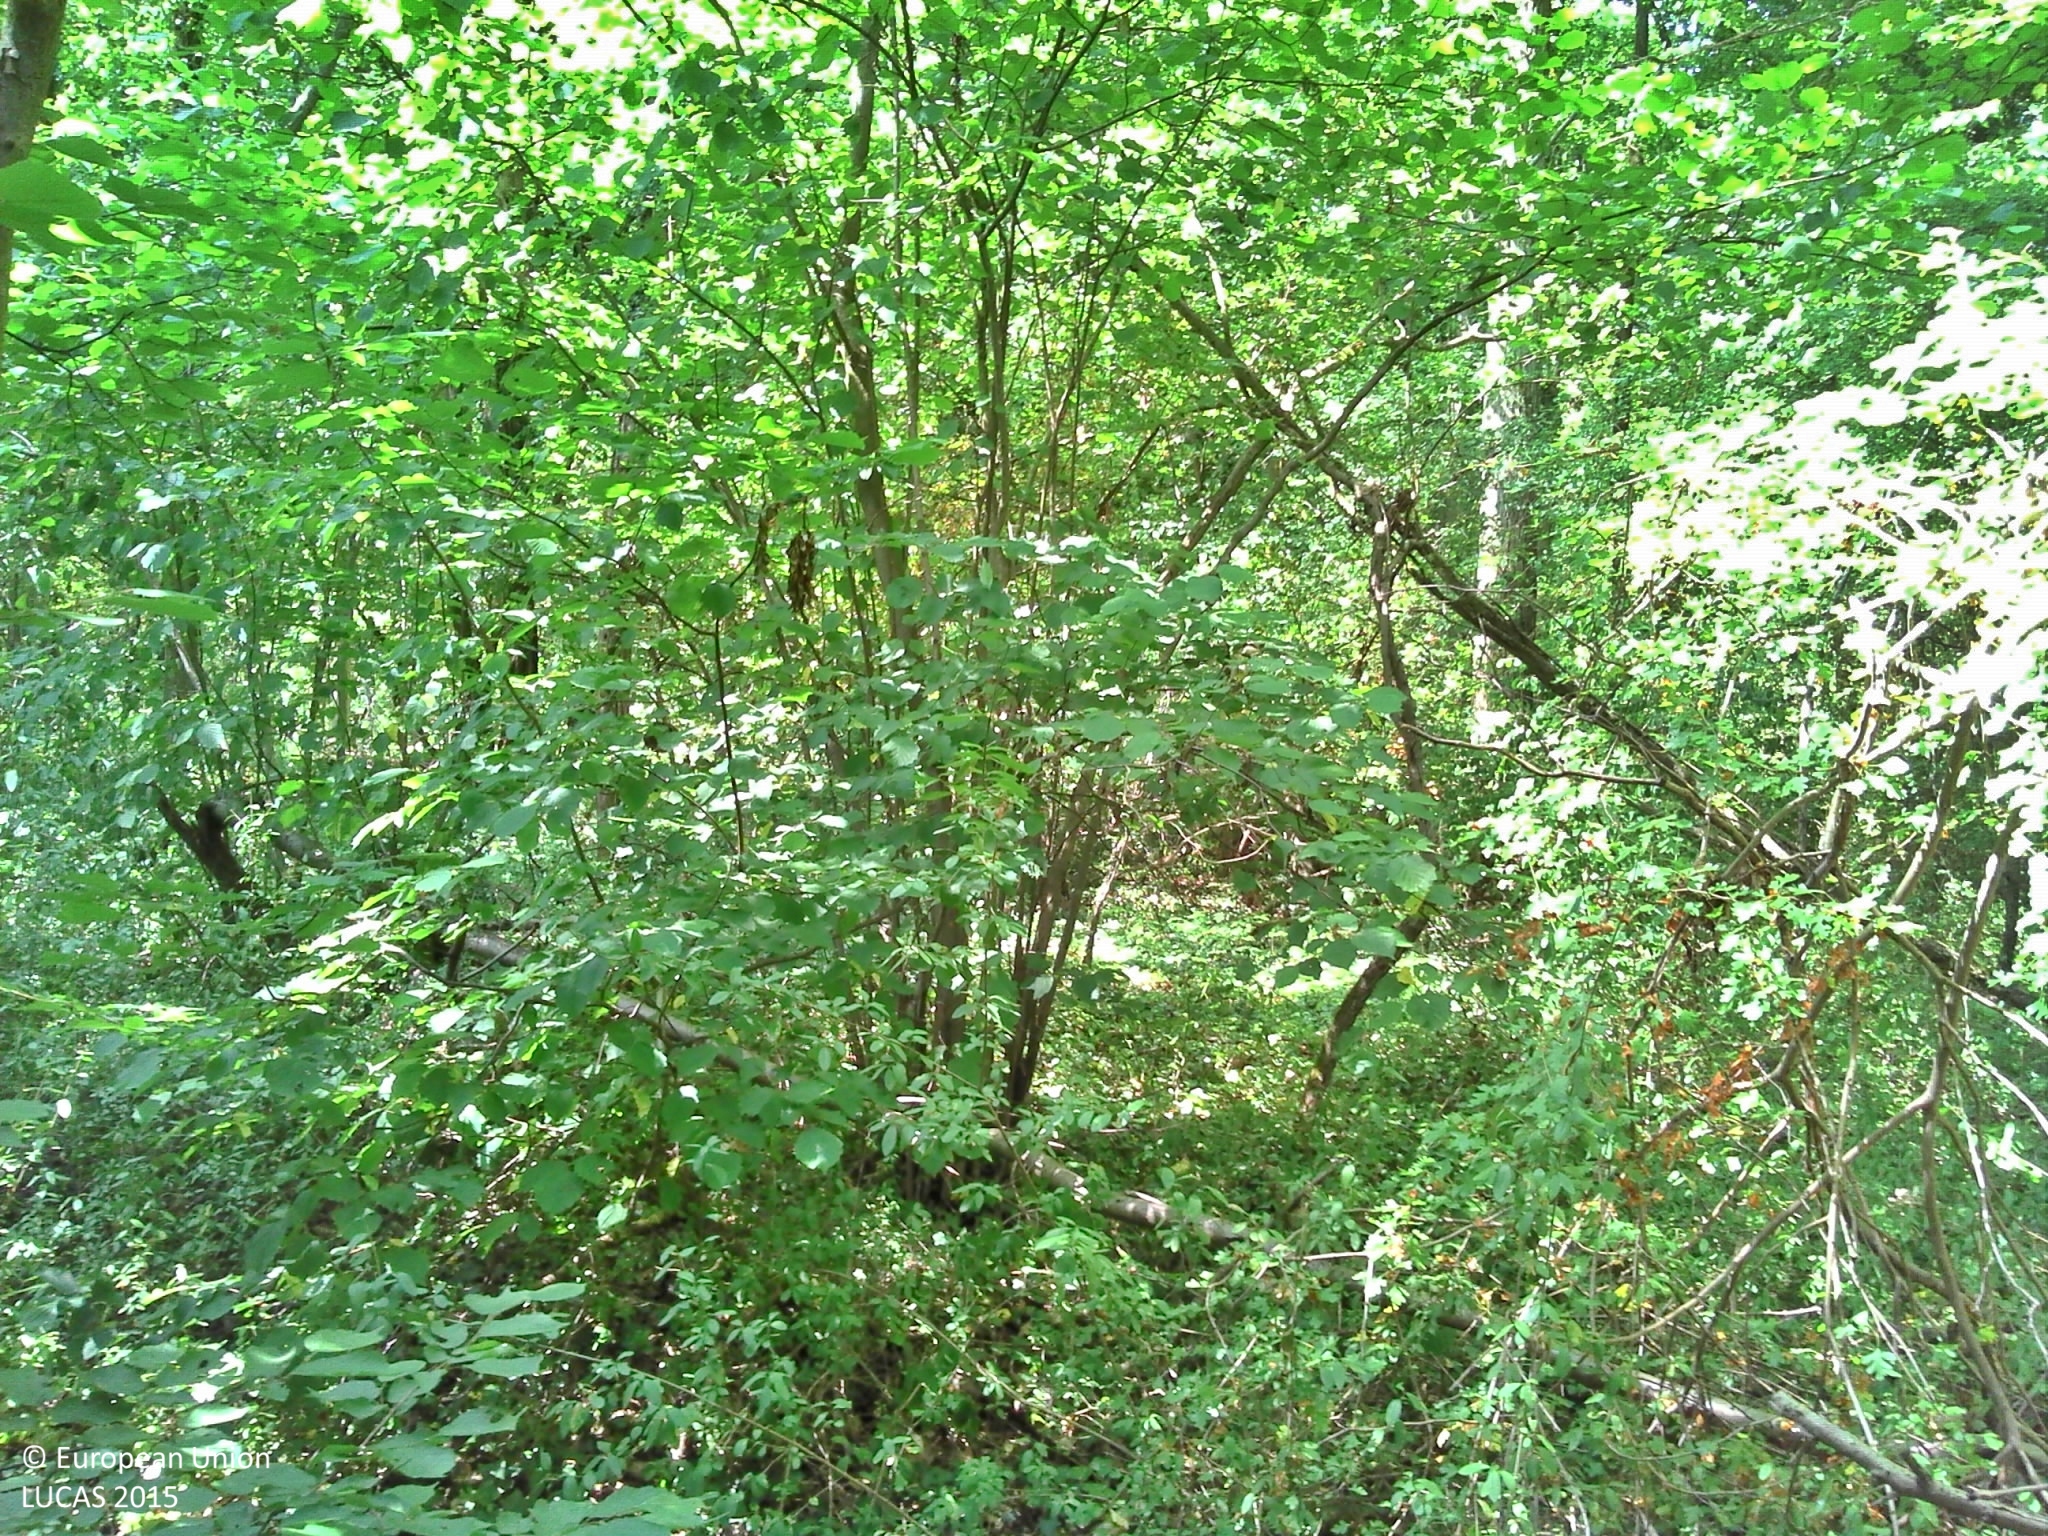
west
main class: Woodland
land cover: Broadleaved woodland
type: mesophytic deciduous forest
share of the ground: > 75 %
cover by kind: broadleaved forest trees 80 %, shrubs 10 %, herbaceous plants 10 %
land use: Forestry
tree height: > 5 m
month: July
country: FR
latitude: 49.2236
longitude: 2.3670
